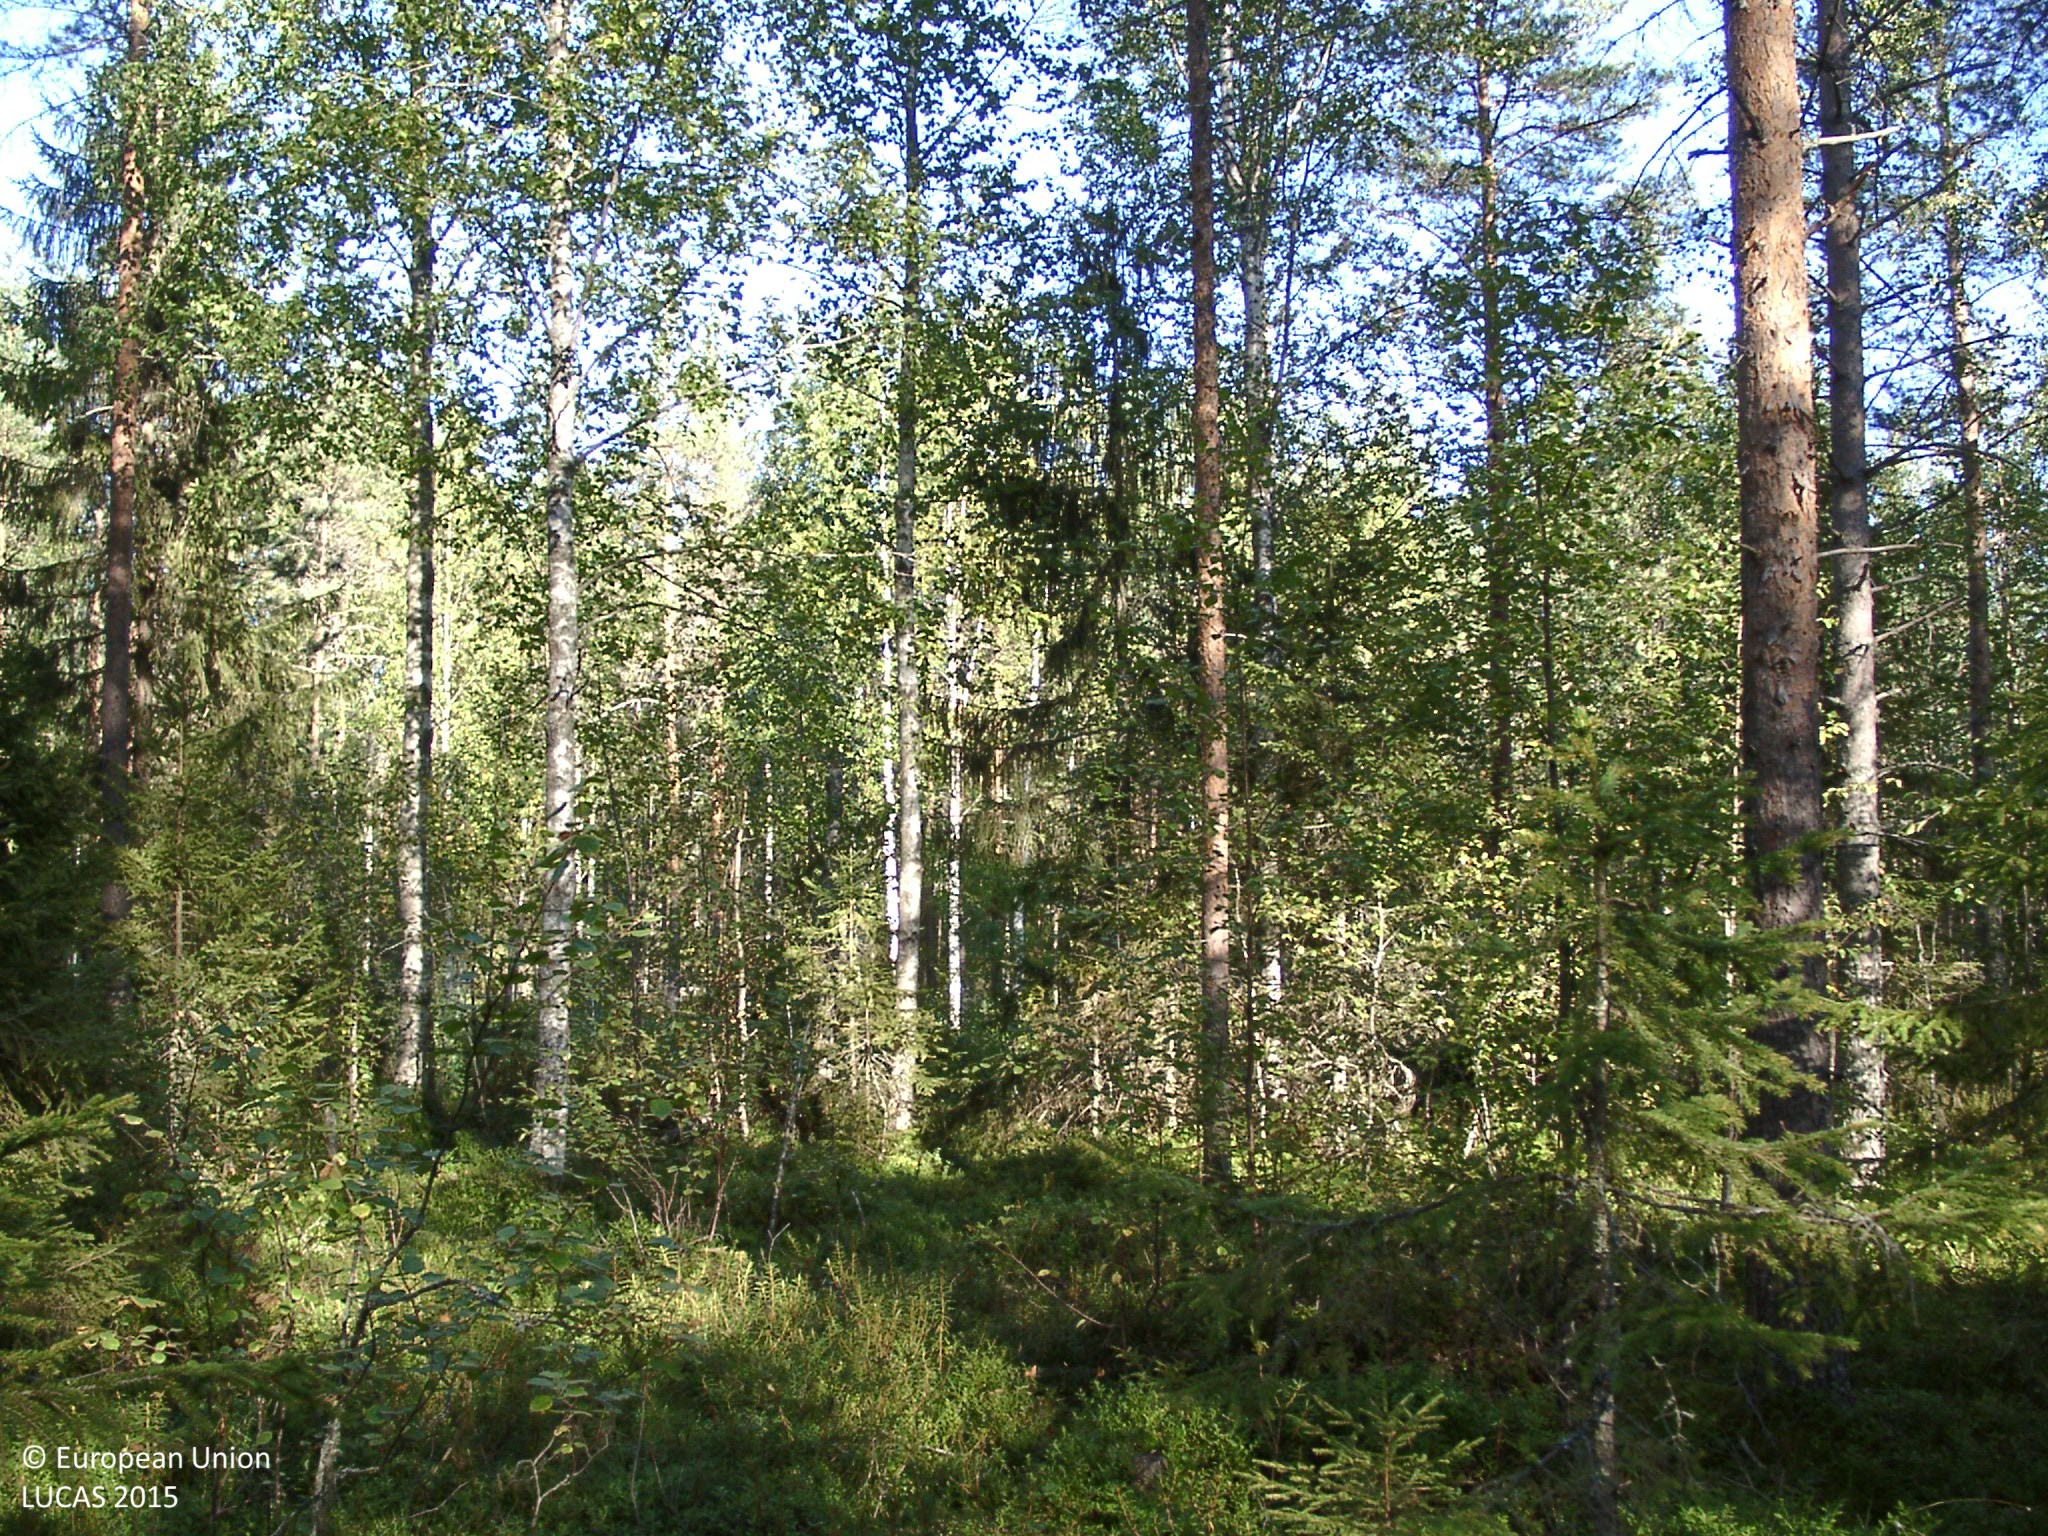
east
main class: Woodland
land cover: Other mixed woodland
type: boreal forest
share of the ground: 50 - 75 %
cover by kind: coniferous forest trees 50 %, shrubs 25 %, broadleaved forest trees 20 %, lichens and mosses 5 %
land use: Forestry
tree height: > 5 m
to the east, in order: Other mixed woodland; Ditches and canals; Shruby margins; Tracks; Shruby margins; Ditches and canals; Other mixed woodland; Ditches and canals; Pine dominated coniferous woodland; Tracks; Other mixed woodland; Tracks; Other mixed woodland; Ditches and canals; Other mixed woodland; Pine dominated coniferous woodland; Spruce dominated mixed woodland; Broadleaved woodland; Ditches and canals; Electric lines; Broadleaved woodland
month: August
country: FI
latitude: 62.4286
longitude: 25.1520
